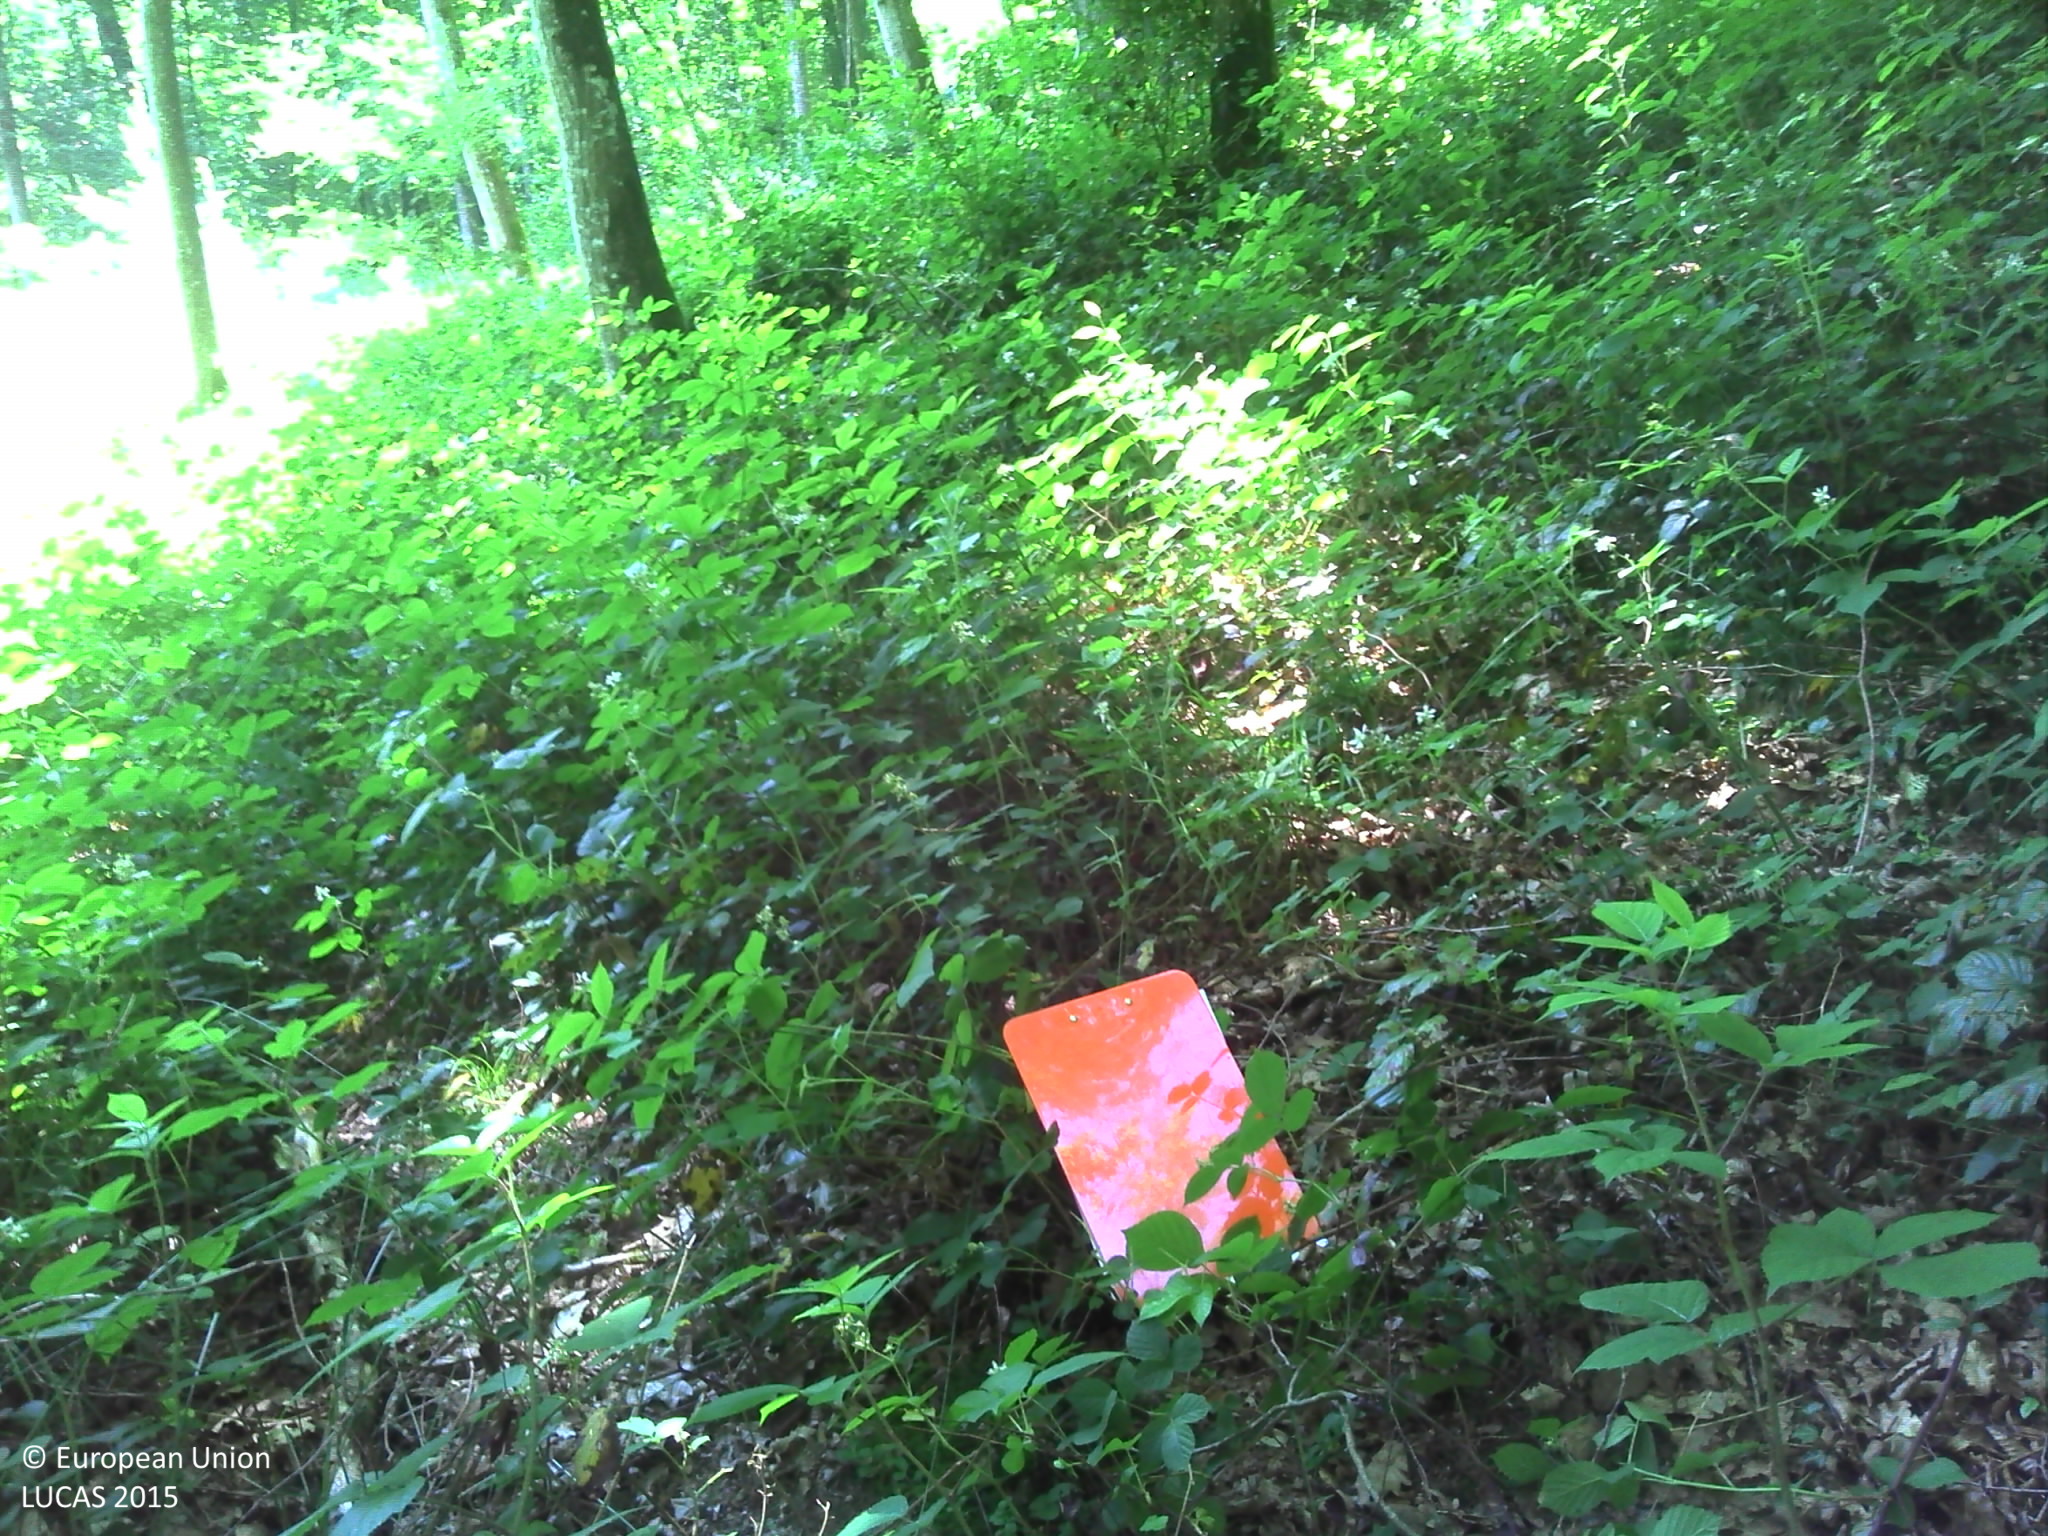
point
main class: Woodland
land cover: Broadleaved woodland
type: mesophytic deciduous forest
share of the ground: > 75 %
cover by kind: broadleaved forest trees 80 %, herbaceous plants 10 %, consolidated bare surface 10 %
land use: Forestry
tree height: > 5 m
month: June
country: FR
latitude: 49.1287
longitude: 1.0848
